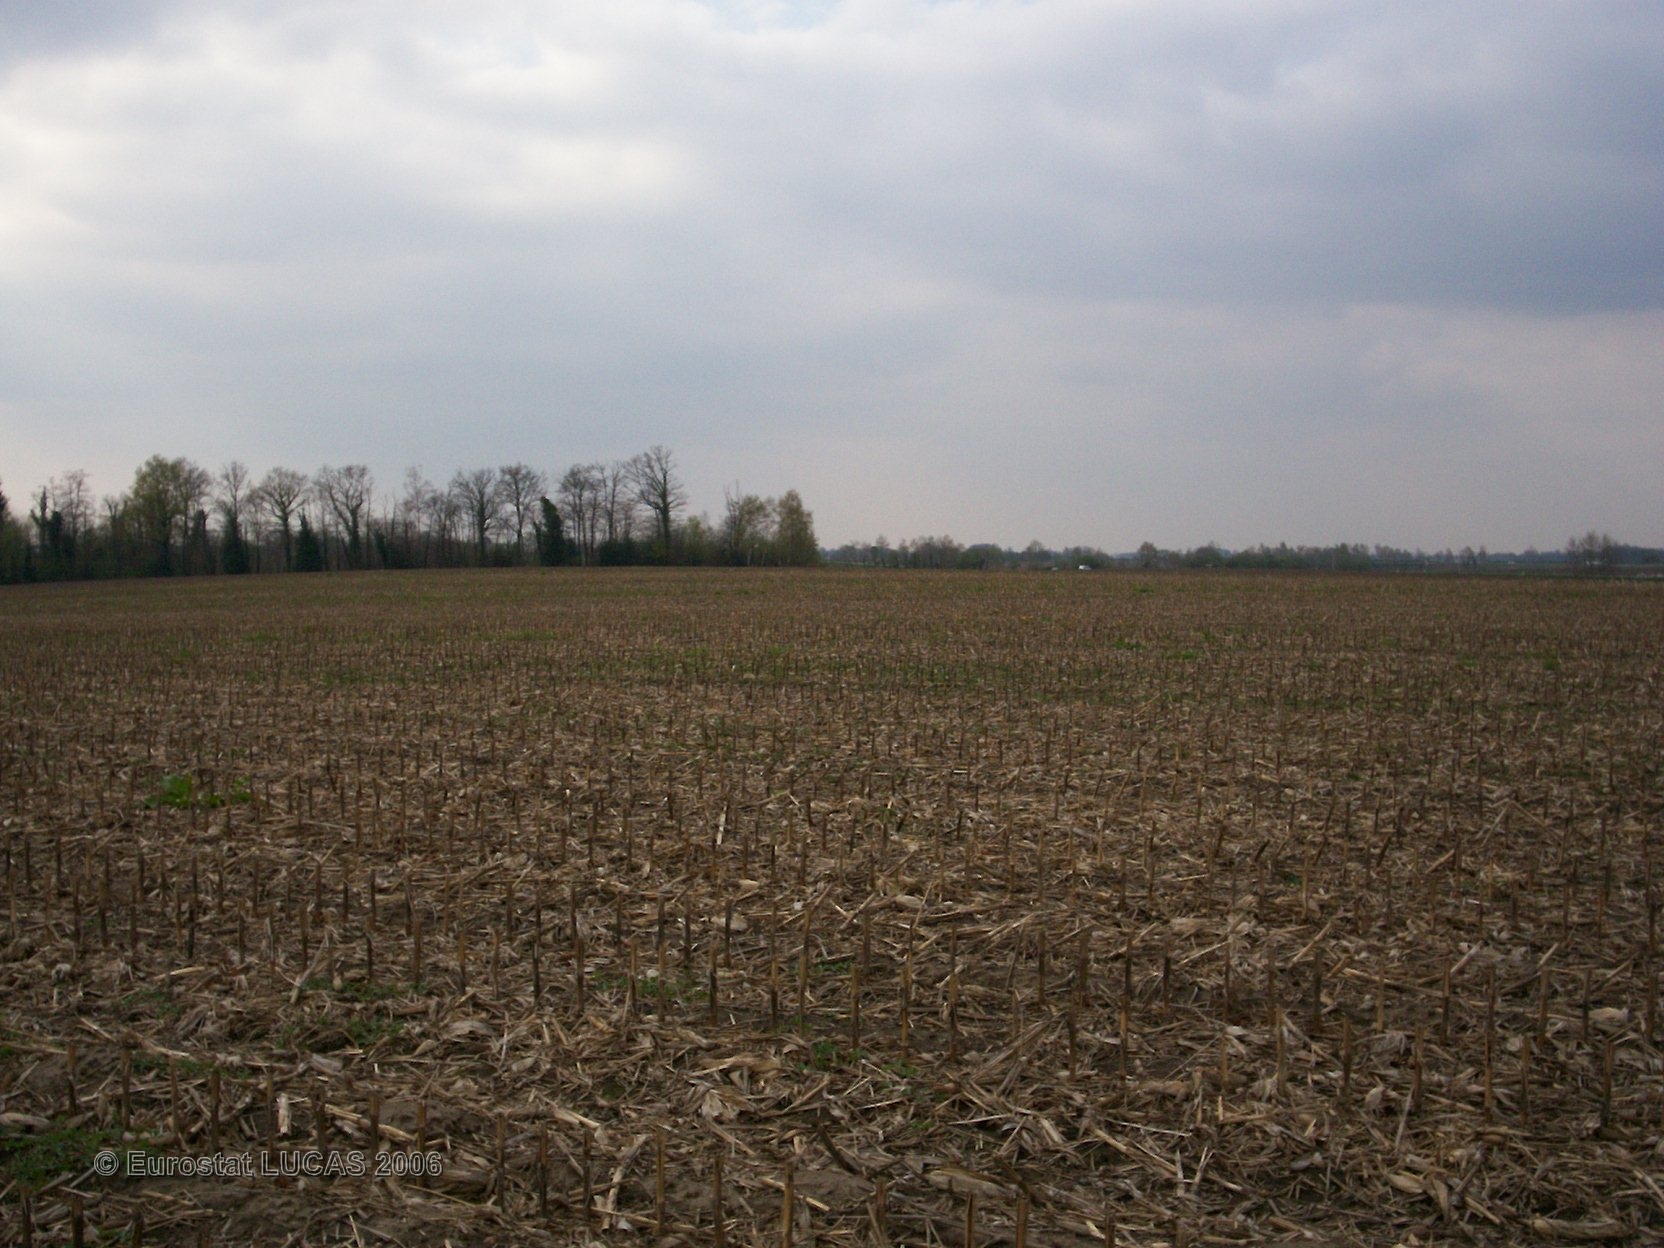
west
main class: Cropland
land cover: Maize
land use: Agriculture (excluding fallow land and kitchen gardens)
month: June
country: FR
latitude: 43.2528
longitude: -0.1419
